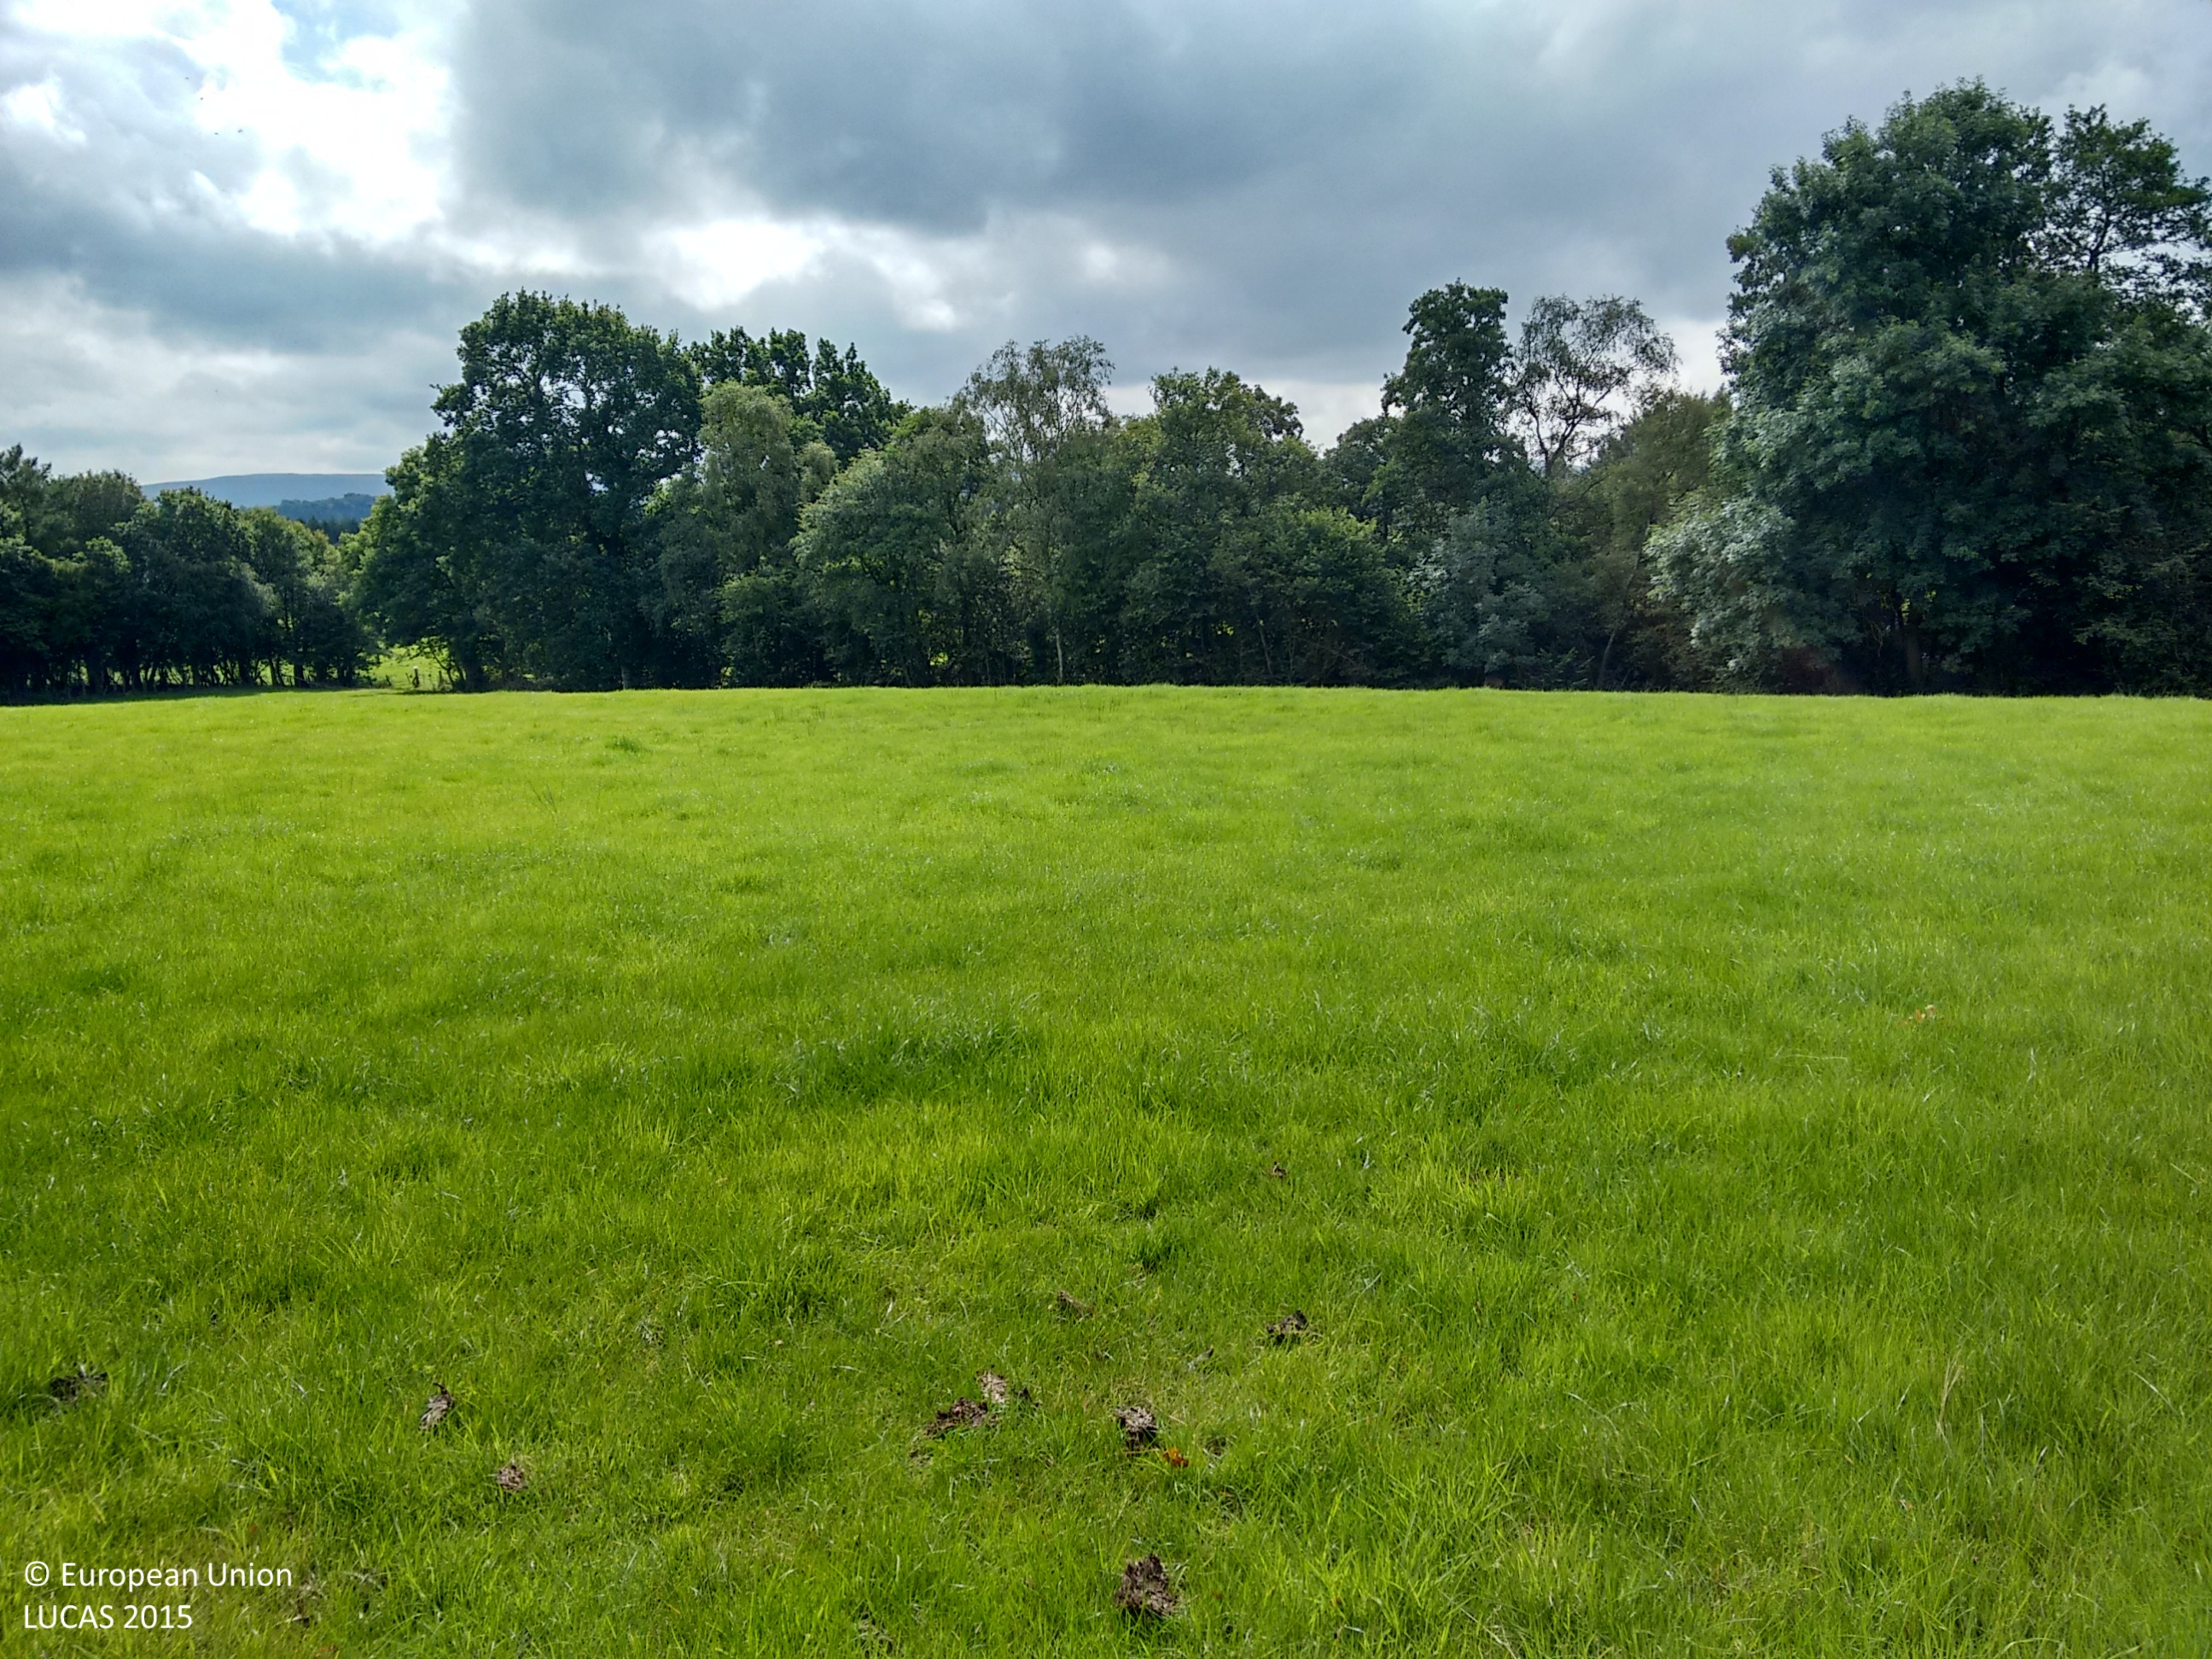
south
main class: Grassland
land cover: Grassland without tree/shrub cover
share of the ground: > 75 %
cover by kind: herbaceous plants 100 %
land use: Agriculture (excluding fallow land and kitchen gardens)
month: September
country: GB
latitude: 52.1890
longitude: -3.4681
